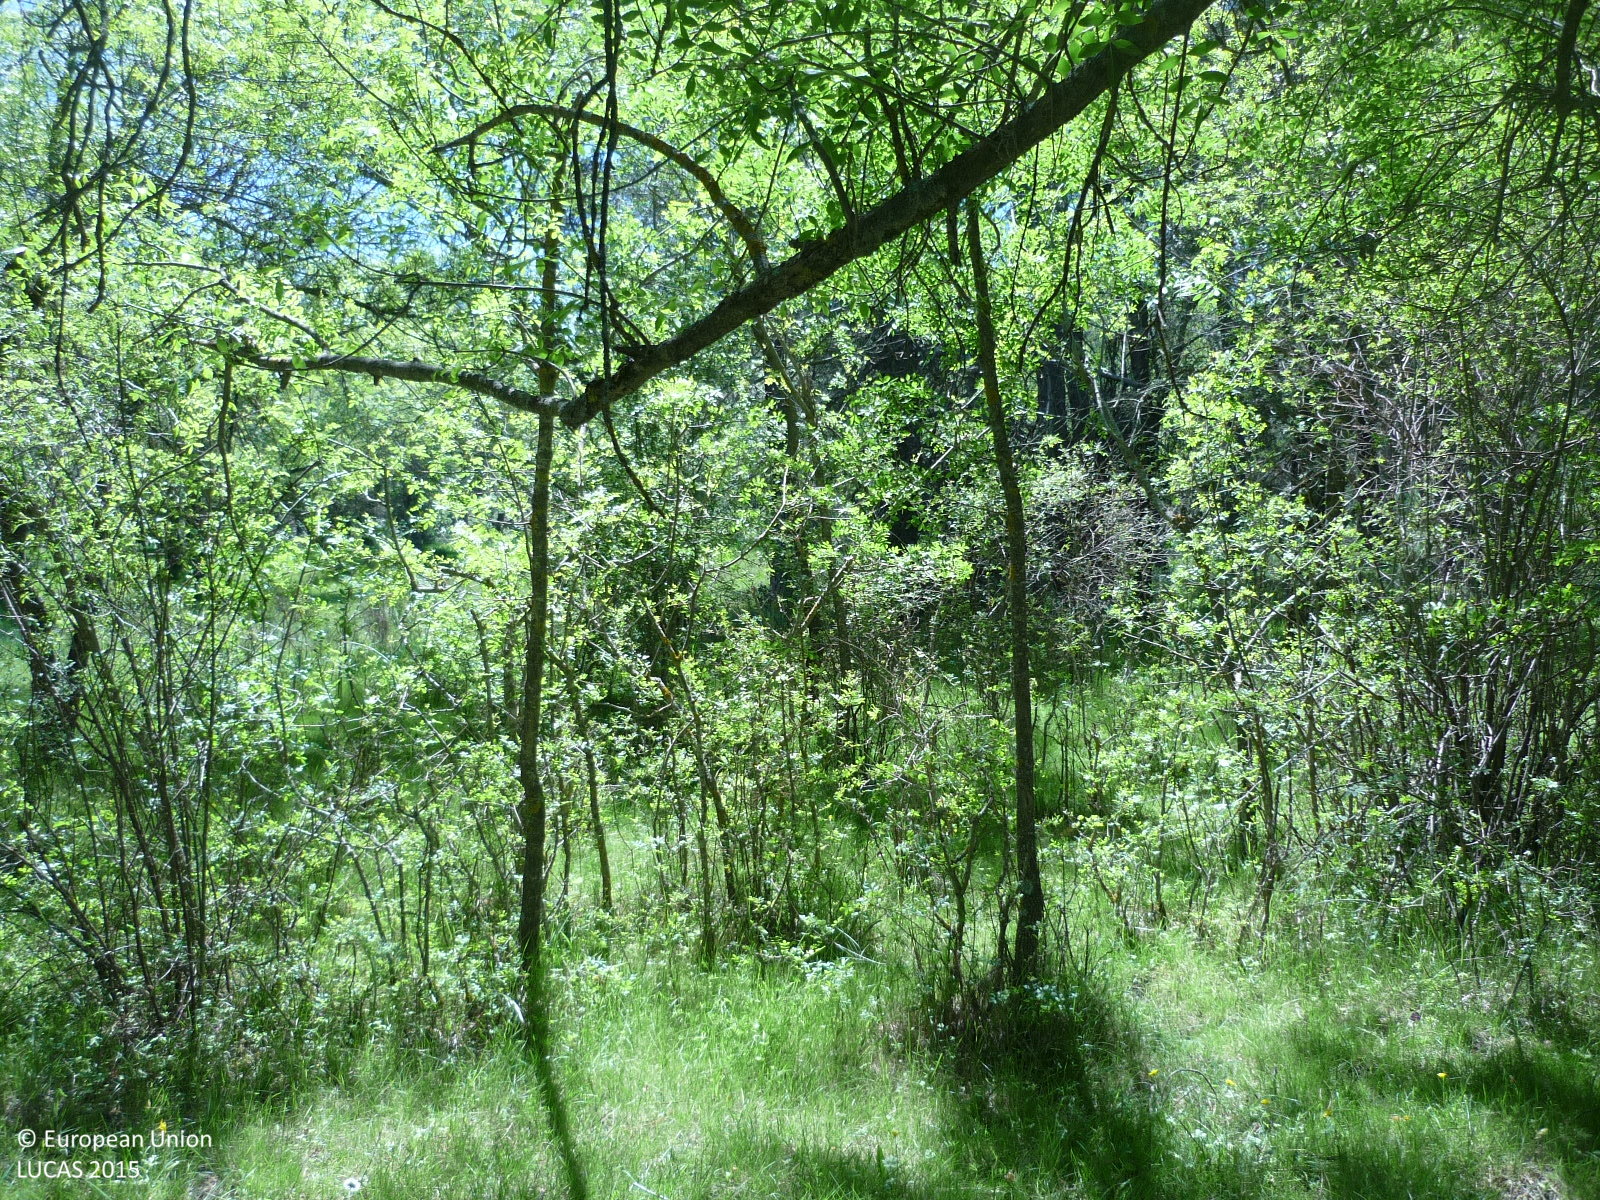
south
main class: Woodland
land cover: Broadleaved woodland
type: thermophilous deciduous forest
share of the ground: > 75 %
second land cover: Grassland without tree/shrub cover
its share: > 75 %
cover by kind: broadleaved forest trees 90 %, herbaceous plants 10 %
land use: Forestry
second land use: Agriculture (excluding fallow land and kitchen gardens)
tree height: < 5 m
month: May
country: ES
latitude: 40.9812
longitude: -3.6042
